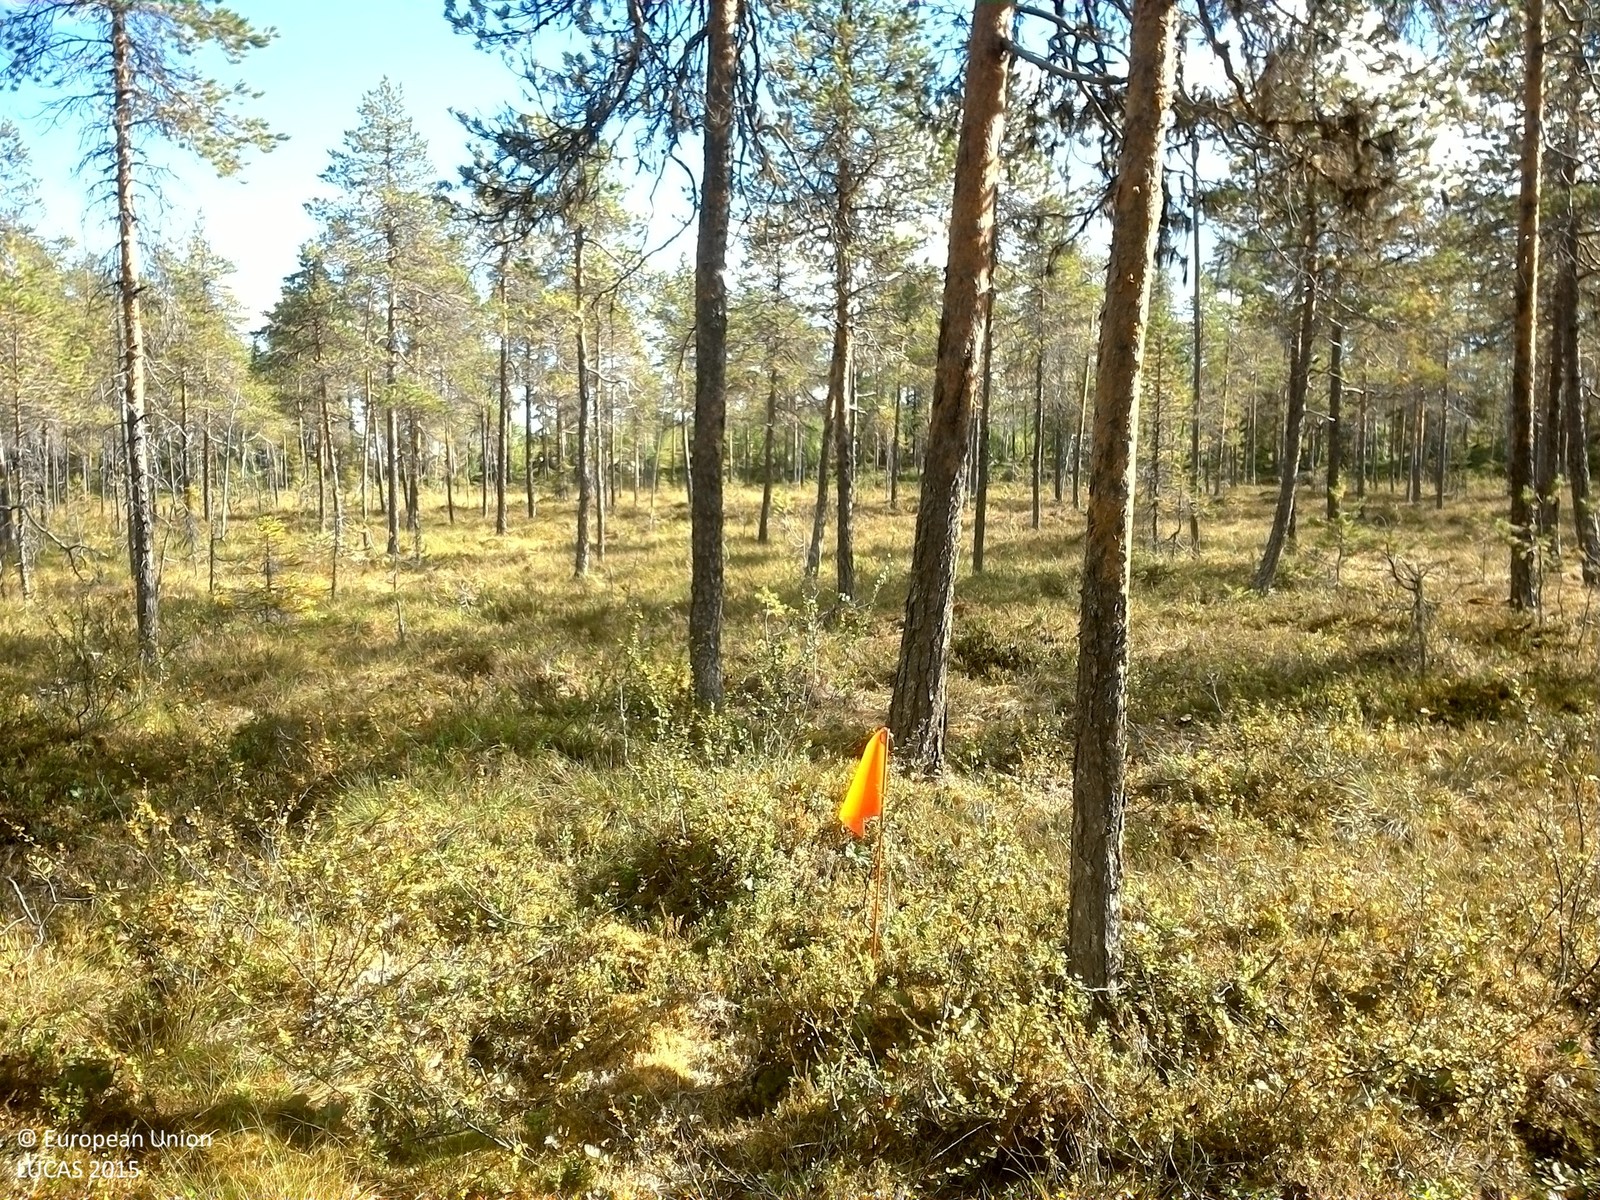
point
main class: Woodland
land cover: Pine dominated coniferous woodland
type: boreal forest
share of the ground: 10 - 25 %
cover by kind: shrubs 40 %, lichens and mosses 35 %, coniferous forest trees 20 %, herbaceous plants 5 %
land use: Semi-natural and natural areas not in use
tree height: > 5 m
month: August
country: SE
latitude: 64.0240
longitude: 17.4396
